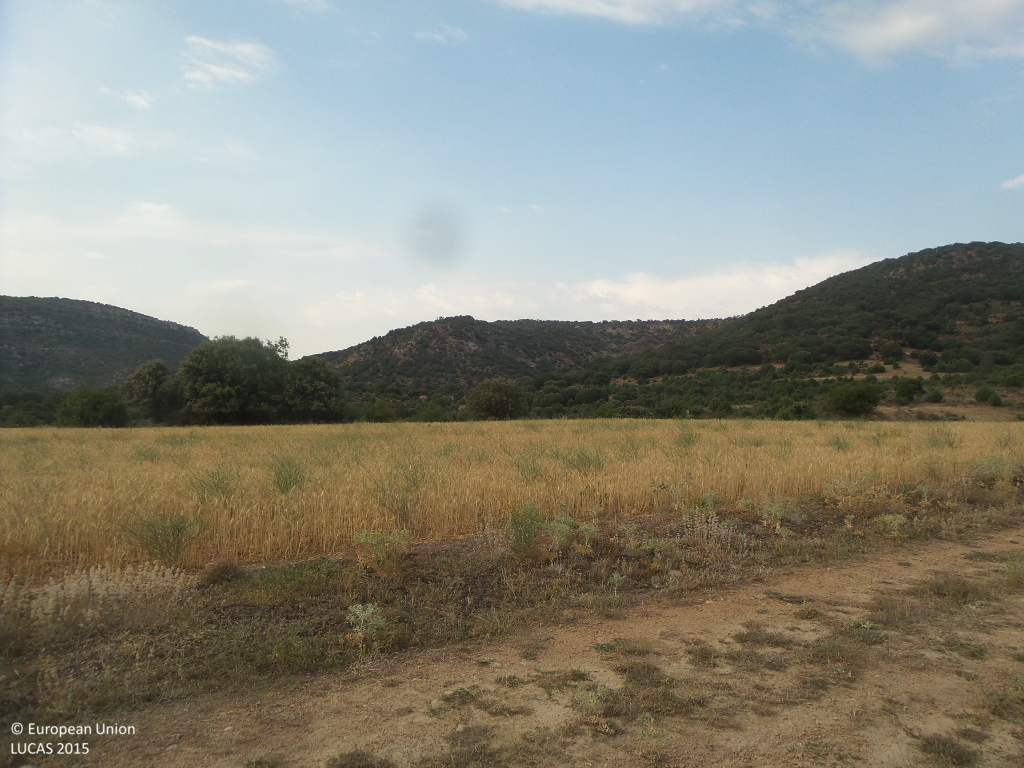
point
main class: Woodland
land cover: Broadleaved woodland
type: broadleaved evergreen forest
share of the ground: > 75 %
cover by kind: broadleaved forest trees 75 %, unconsolidated bare surface 15 %, shrubs 5 %, herbaceous plants 5 %
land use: Semi-natural and natural areas not in use
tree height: < 5 m
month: July
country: ES
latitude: 41.0942
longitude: -2.7610
